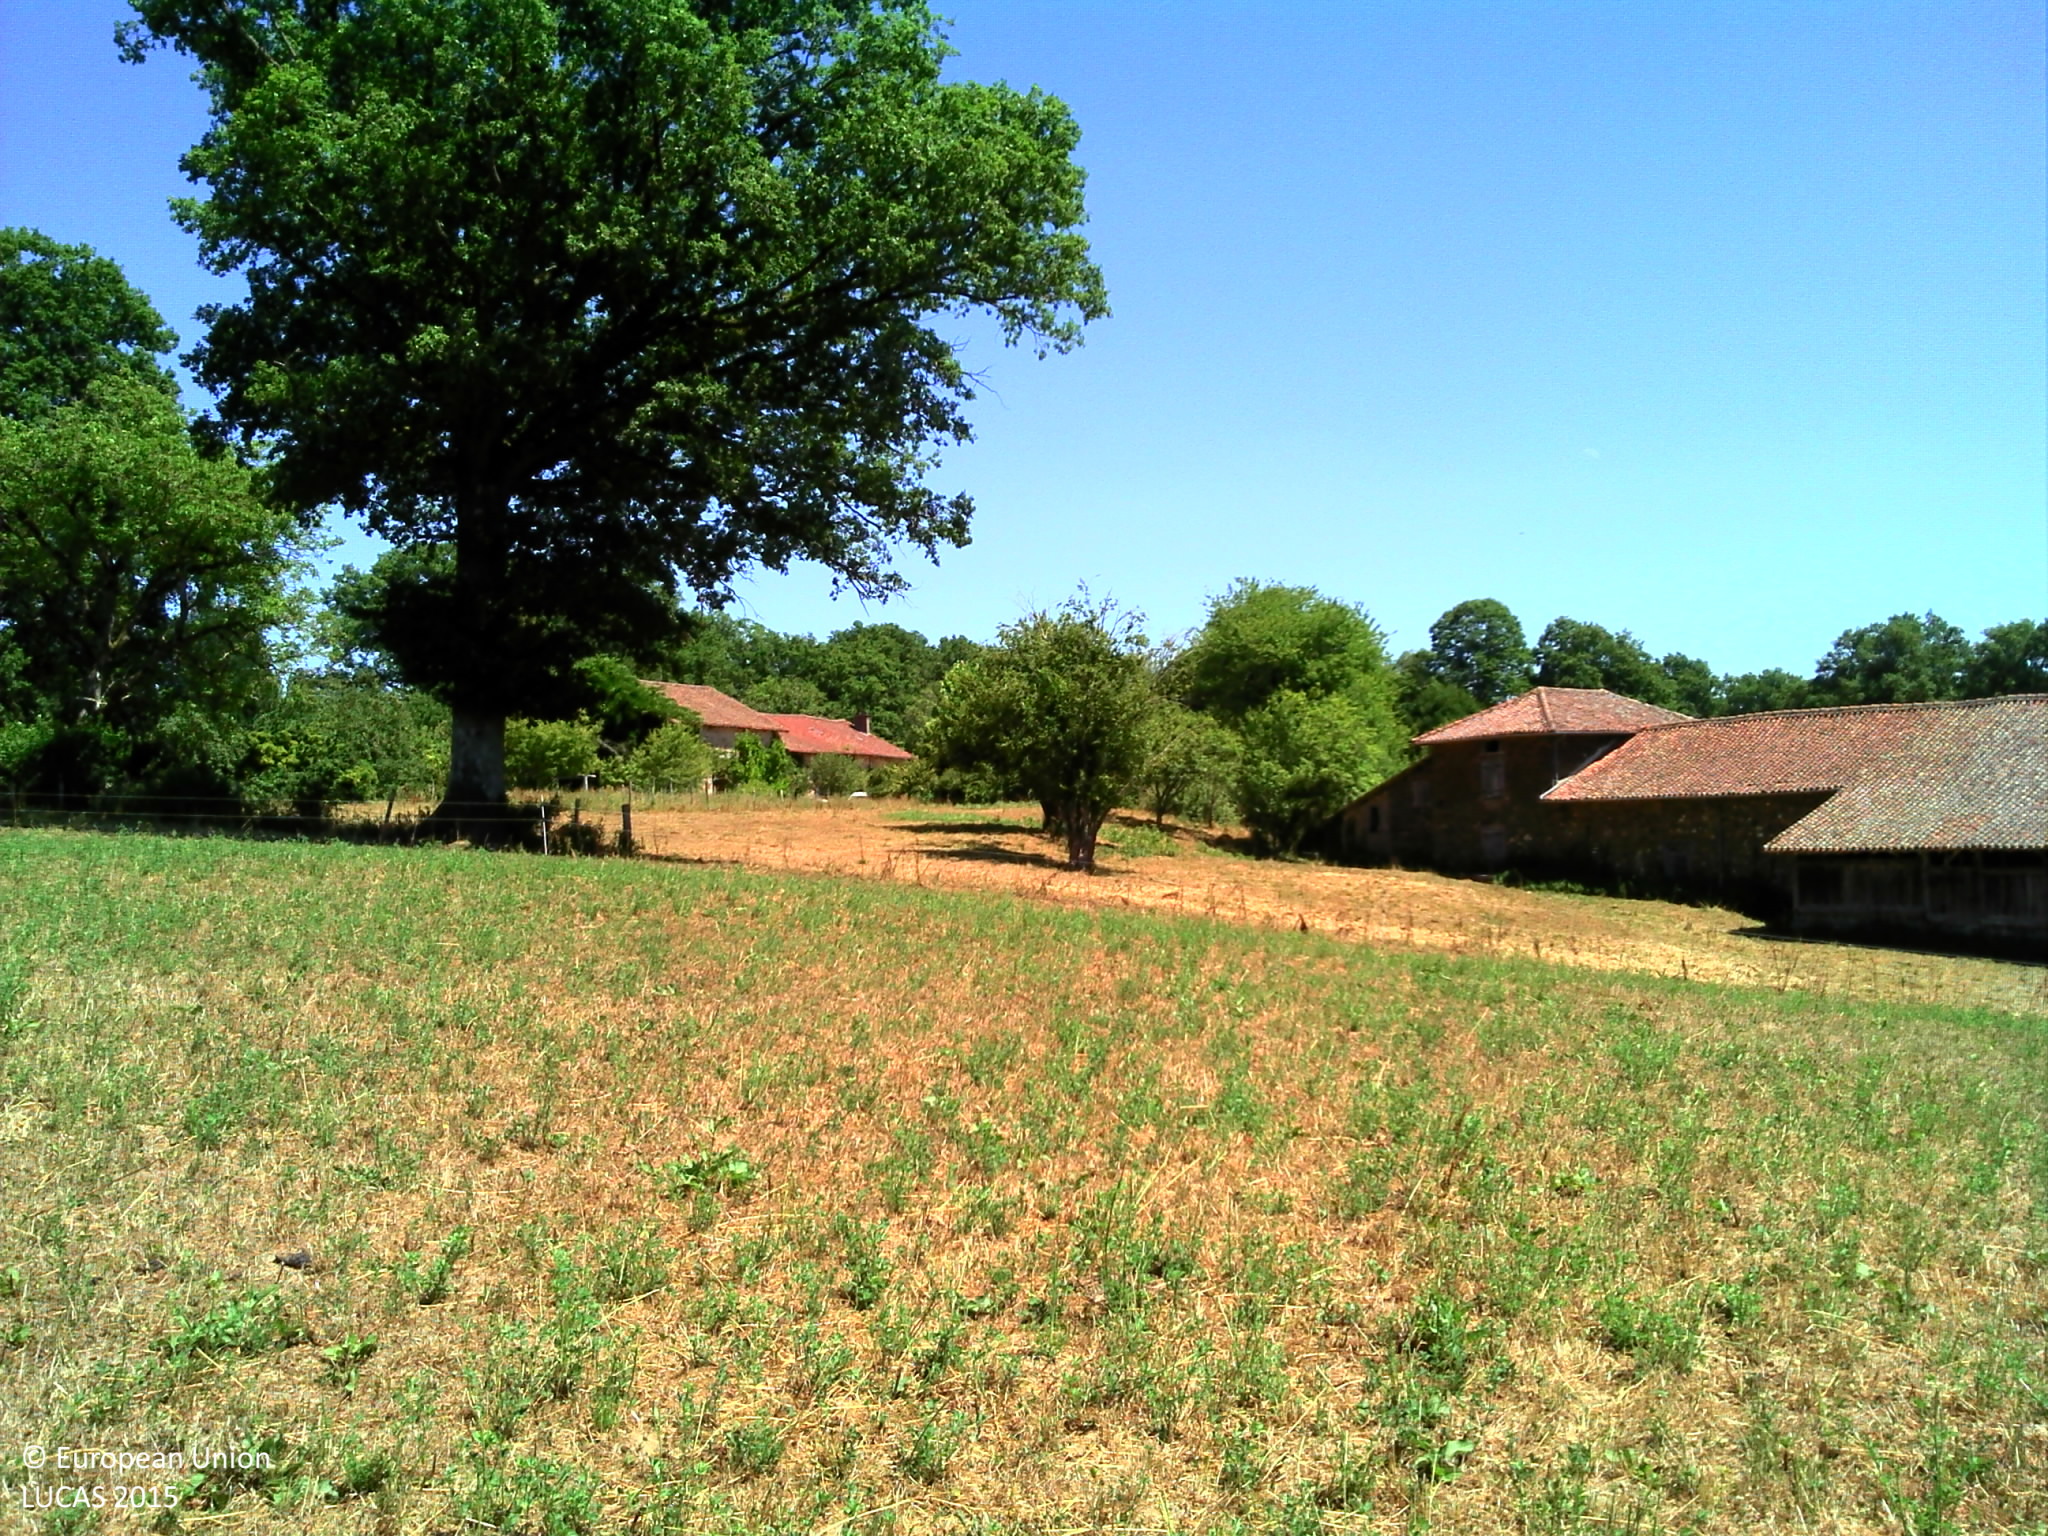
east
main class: Grassland
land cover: Grassland without tree/shrub cover
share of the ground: > 75 %
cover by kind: herbaceous plants 95 %
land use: Agriculture (excluding fallow land and kitchen gardens)
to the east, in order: Grassland without tree/shrub cover; Grassland with sparse tree/shrub cover; Fences; Grassland with sparse tree/shrub cover; Artificial constructions in urban areas; Tracks; Abandoned hedges; Grass margins; Abandoned hedges; Fences; Grassland without tree/shrub cover; Abandoned hedges; Fences
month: July
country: FR
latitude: 45.7185
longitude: 1.4489
